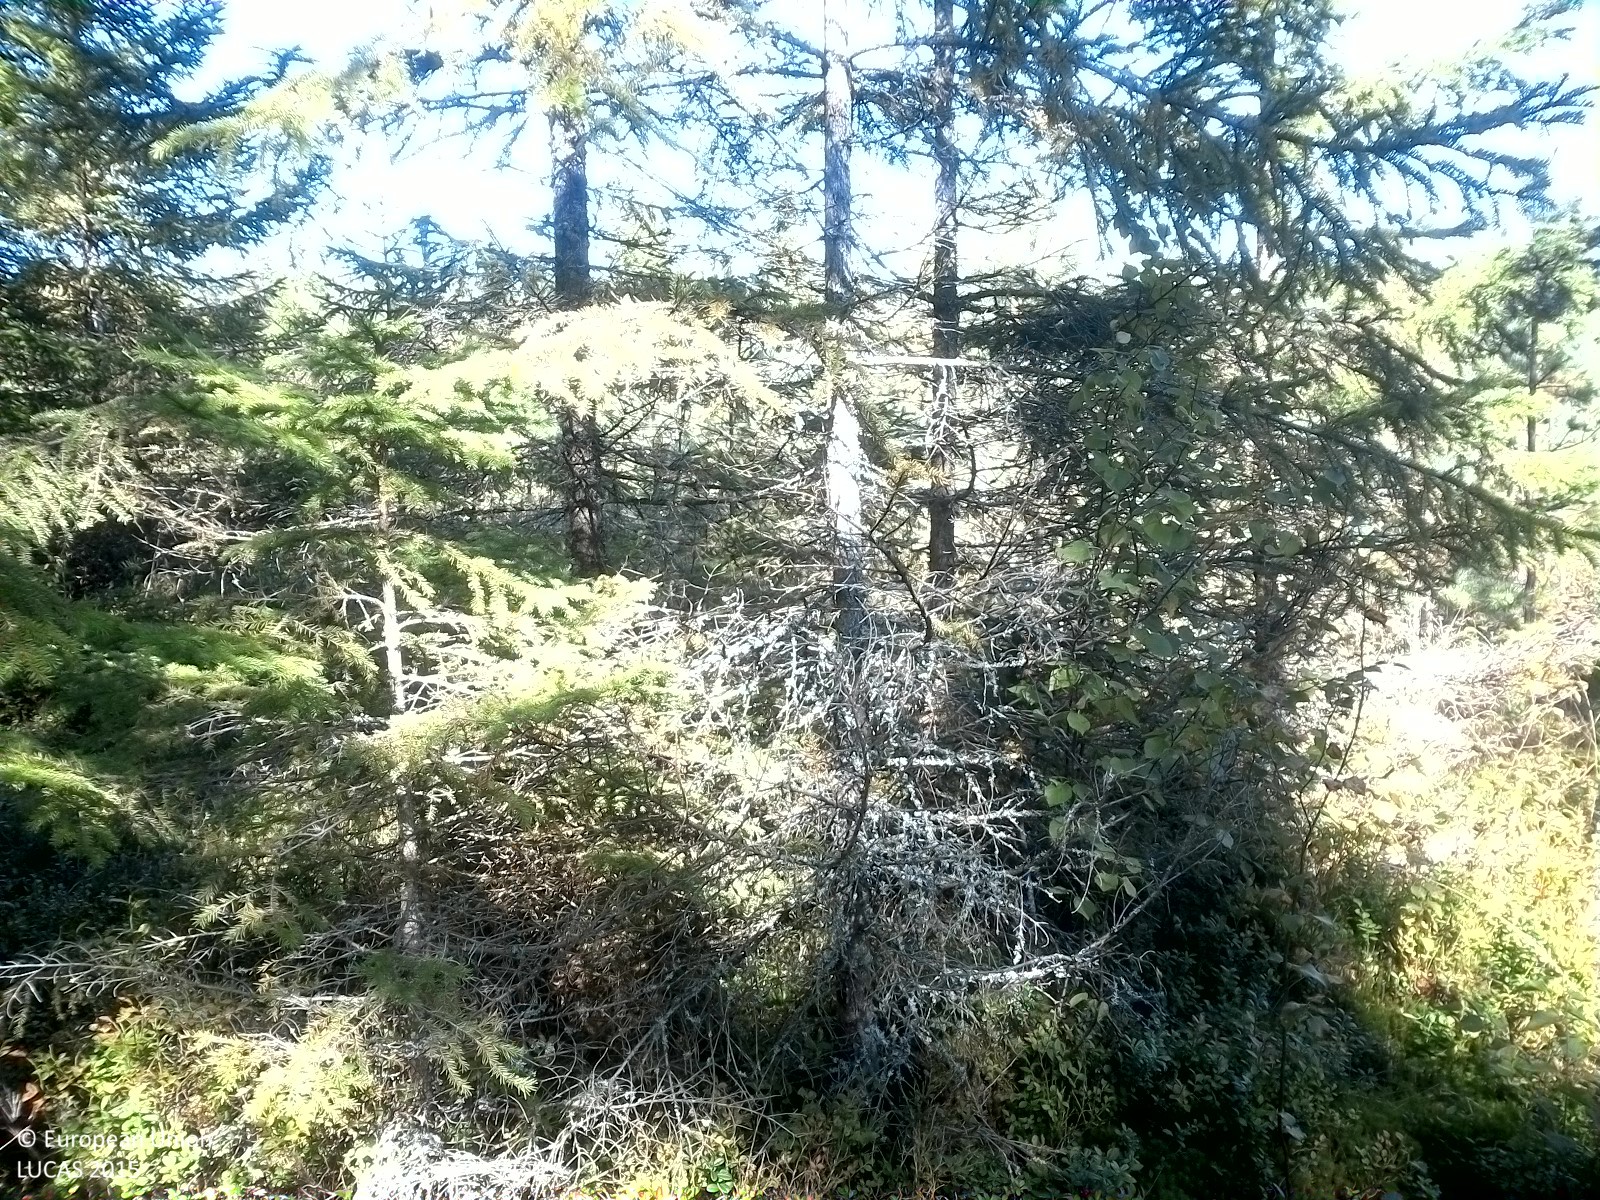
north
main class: Woodland
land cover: Spruce dominated mixed woodland
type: boreal forest
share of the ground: 50 - 75 %
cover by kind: coniferous forest trees 35 %, herbaceous plants 30 %, broadleaved forest trees 25 %, lichens and mosses 10 %
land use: Forestry
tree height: < 5 m
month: September
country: SE
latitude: 59.0313
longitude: 15.8298
